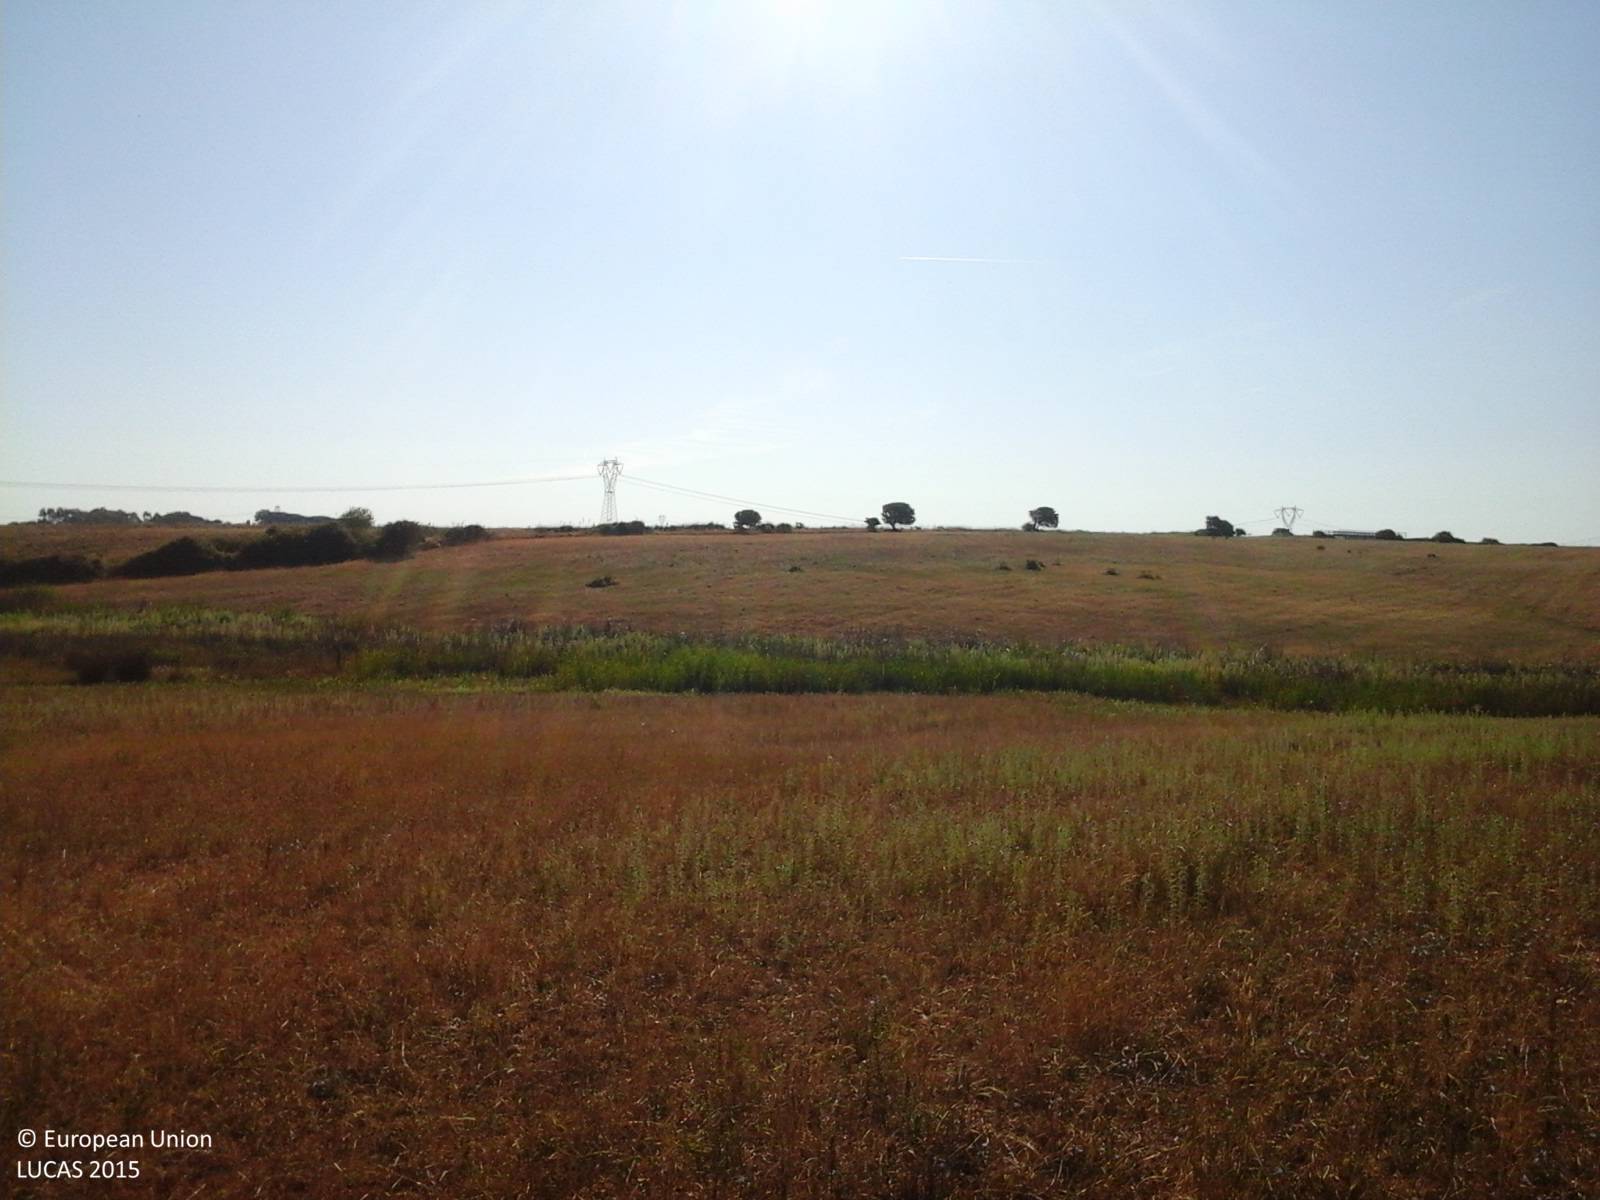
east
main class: Grassland
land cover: Grassland without tree/shrub cover
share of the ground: > 75 %
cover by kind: herbaceous plants 100 %
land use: Agriculture (excluding fallow land and kitchen gardens)
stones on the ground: < 10 %
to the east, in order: Grassland without tree/shrub cover; Inland fresh water bodies; Inland marshes; Fences; Grass margins; Tracks; Fences; Grass margins; Tracks; Grassland without tree/shrub cover
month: June
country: IT
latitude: 40.7070
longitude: 8.4098
